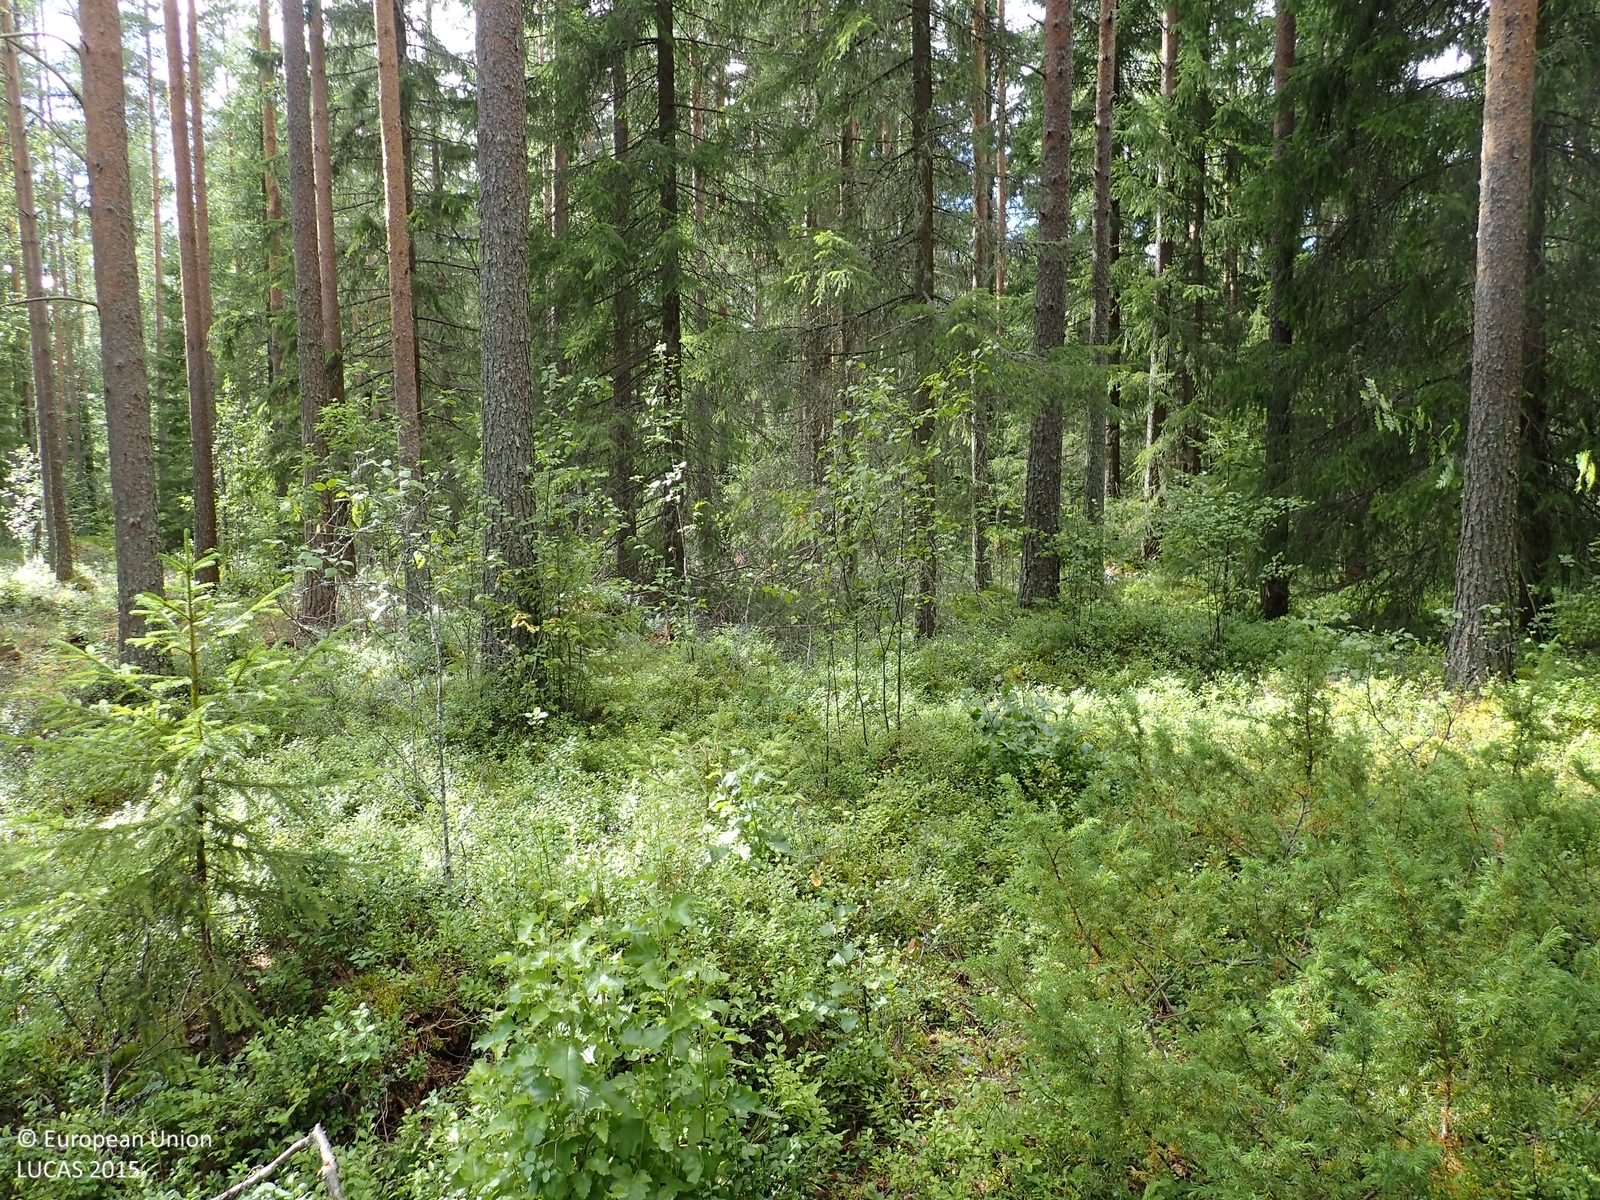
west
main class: Woodland
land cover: Other coniferous woodland
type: boreal forest
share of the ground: > 75 %
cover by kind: coniferous forest trees 70 %, shrubs 20 %, broadleaved forest trees 10 %
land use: Forestry
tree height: > 5 m
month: August
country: FI
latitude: 62.6364
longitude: 21.8447
